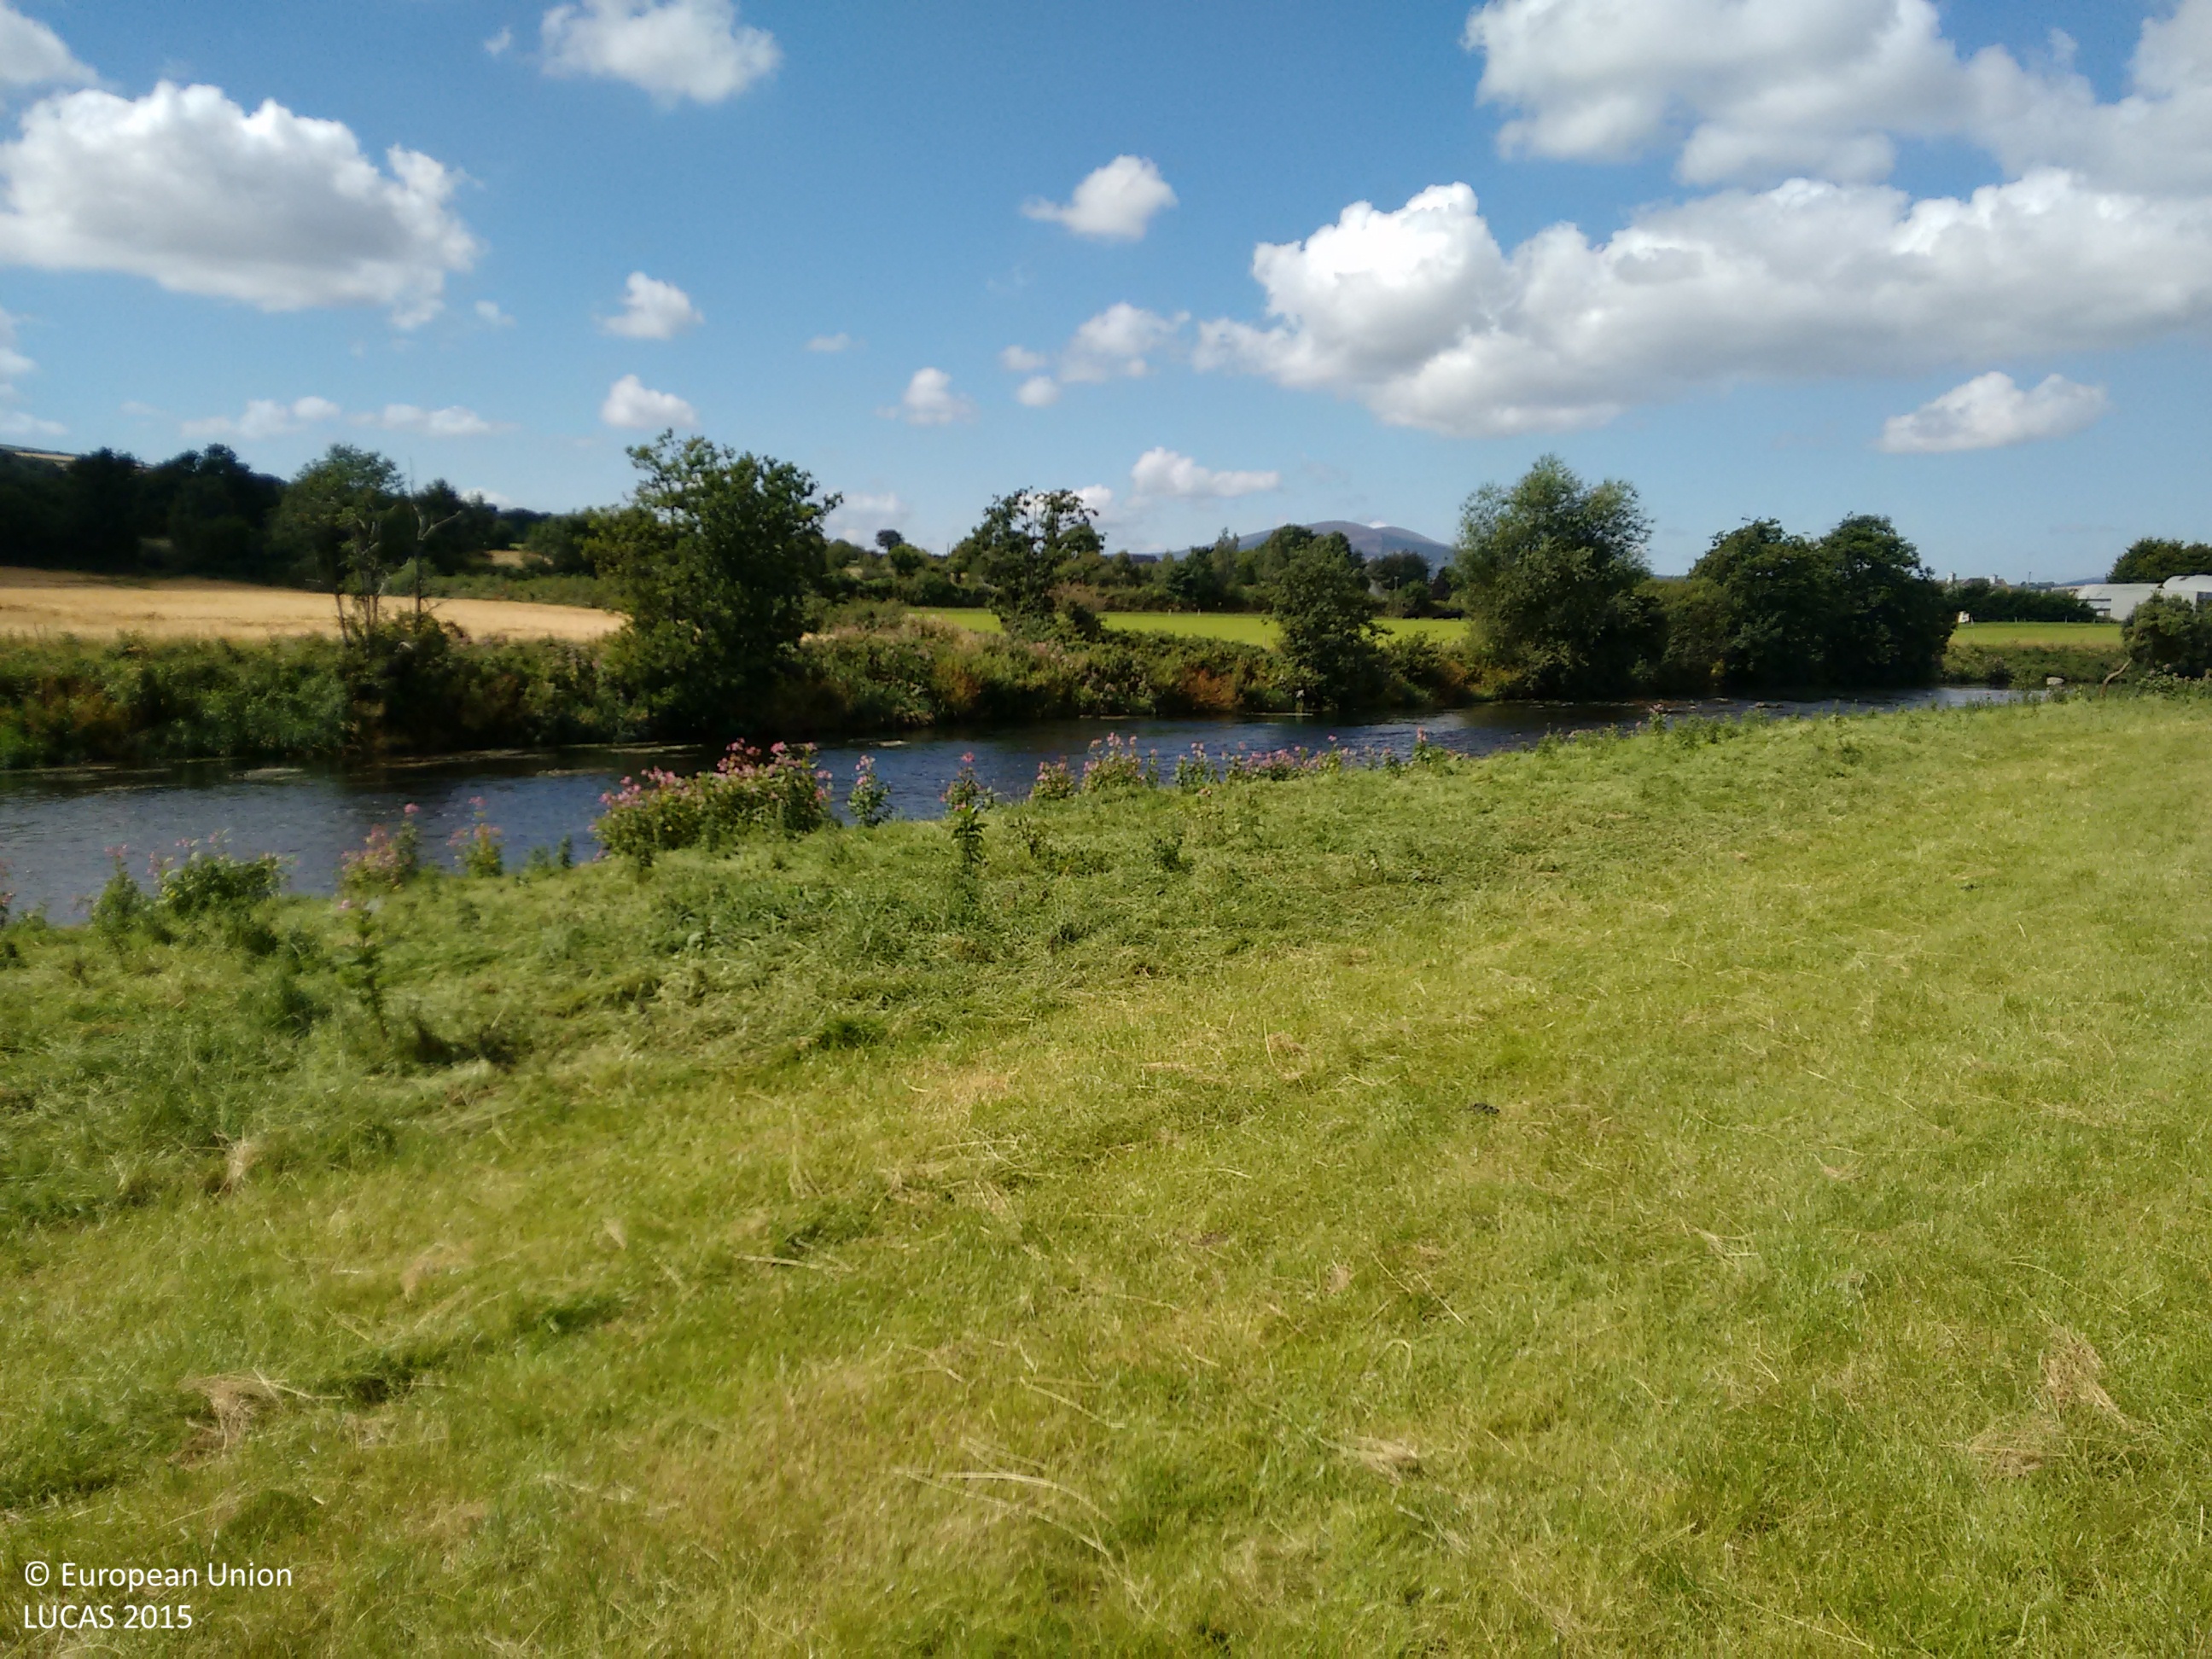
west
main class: Grassland
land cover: Grassland without tree/shrub cover
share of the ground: > 75 %
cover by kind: herbaceous plants 100 %
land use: Agriculture (excluding fallow land and kitchen gardens)
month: August
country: IE
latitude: 52.6123
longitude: -6.5974
